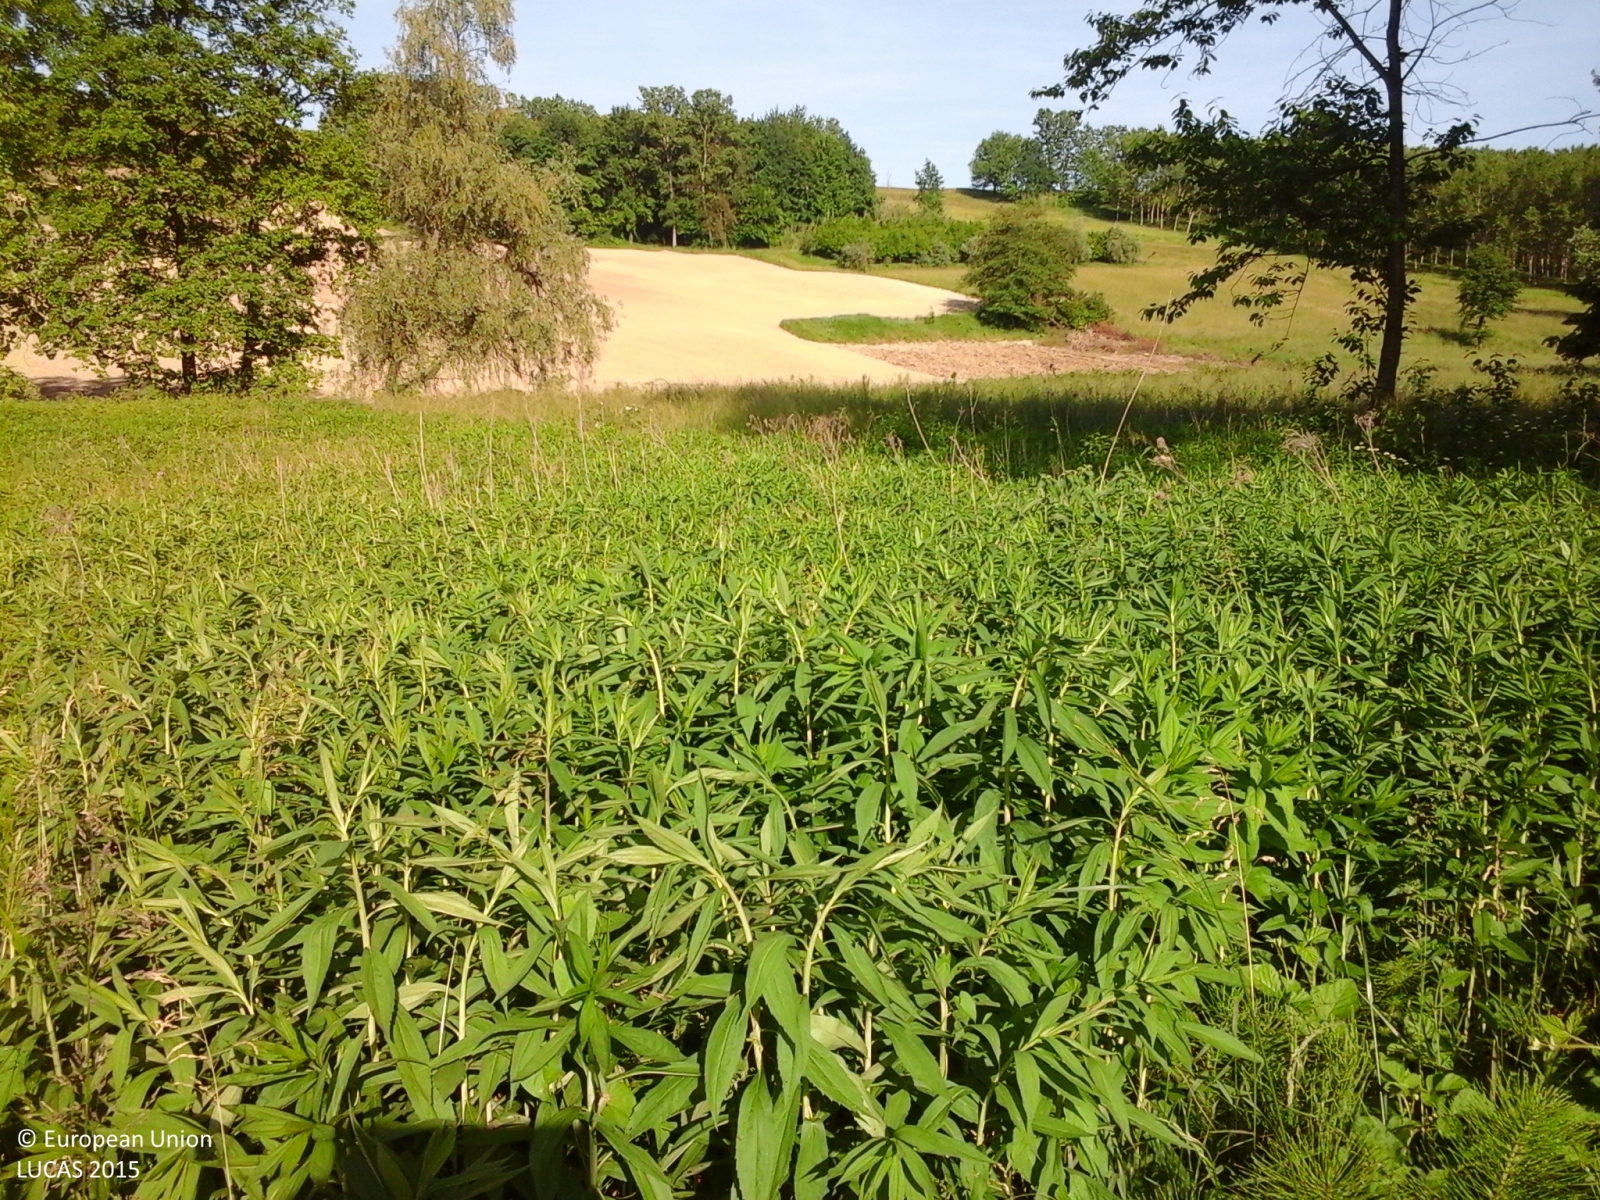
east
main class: Grassland
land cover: Spontaneously vegetated surfaces
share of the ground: > 75 %
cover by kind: herbaceous plants 100 %
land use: Agriculture (excluding fallow land and kitchen gardens)
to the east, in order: Spontaneously vegetated surfaces; Tracks; Grass margins; Ditches and canals; Abandoned hedges; Grass margins; Other bare soil
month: May
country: IT
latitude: 45.0188
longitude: 8.1127
